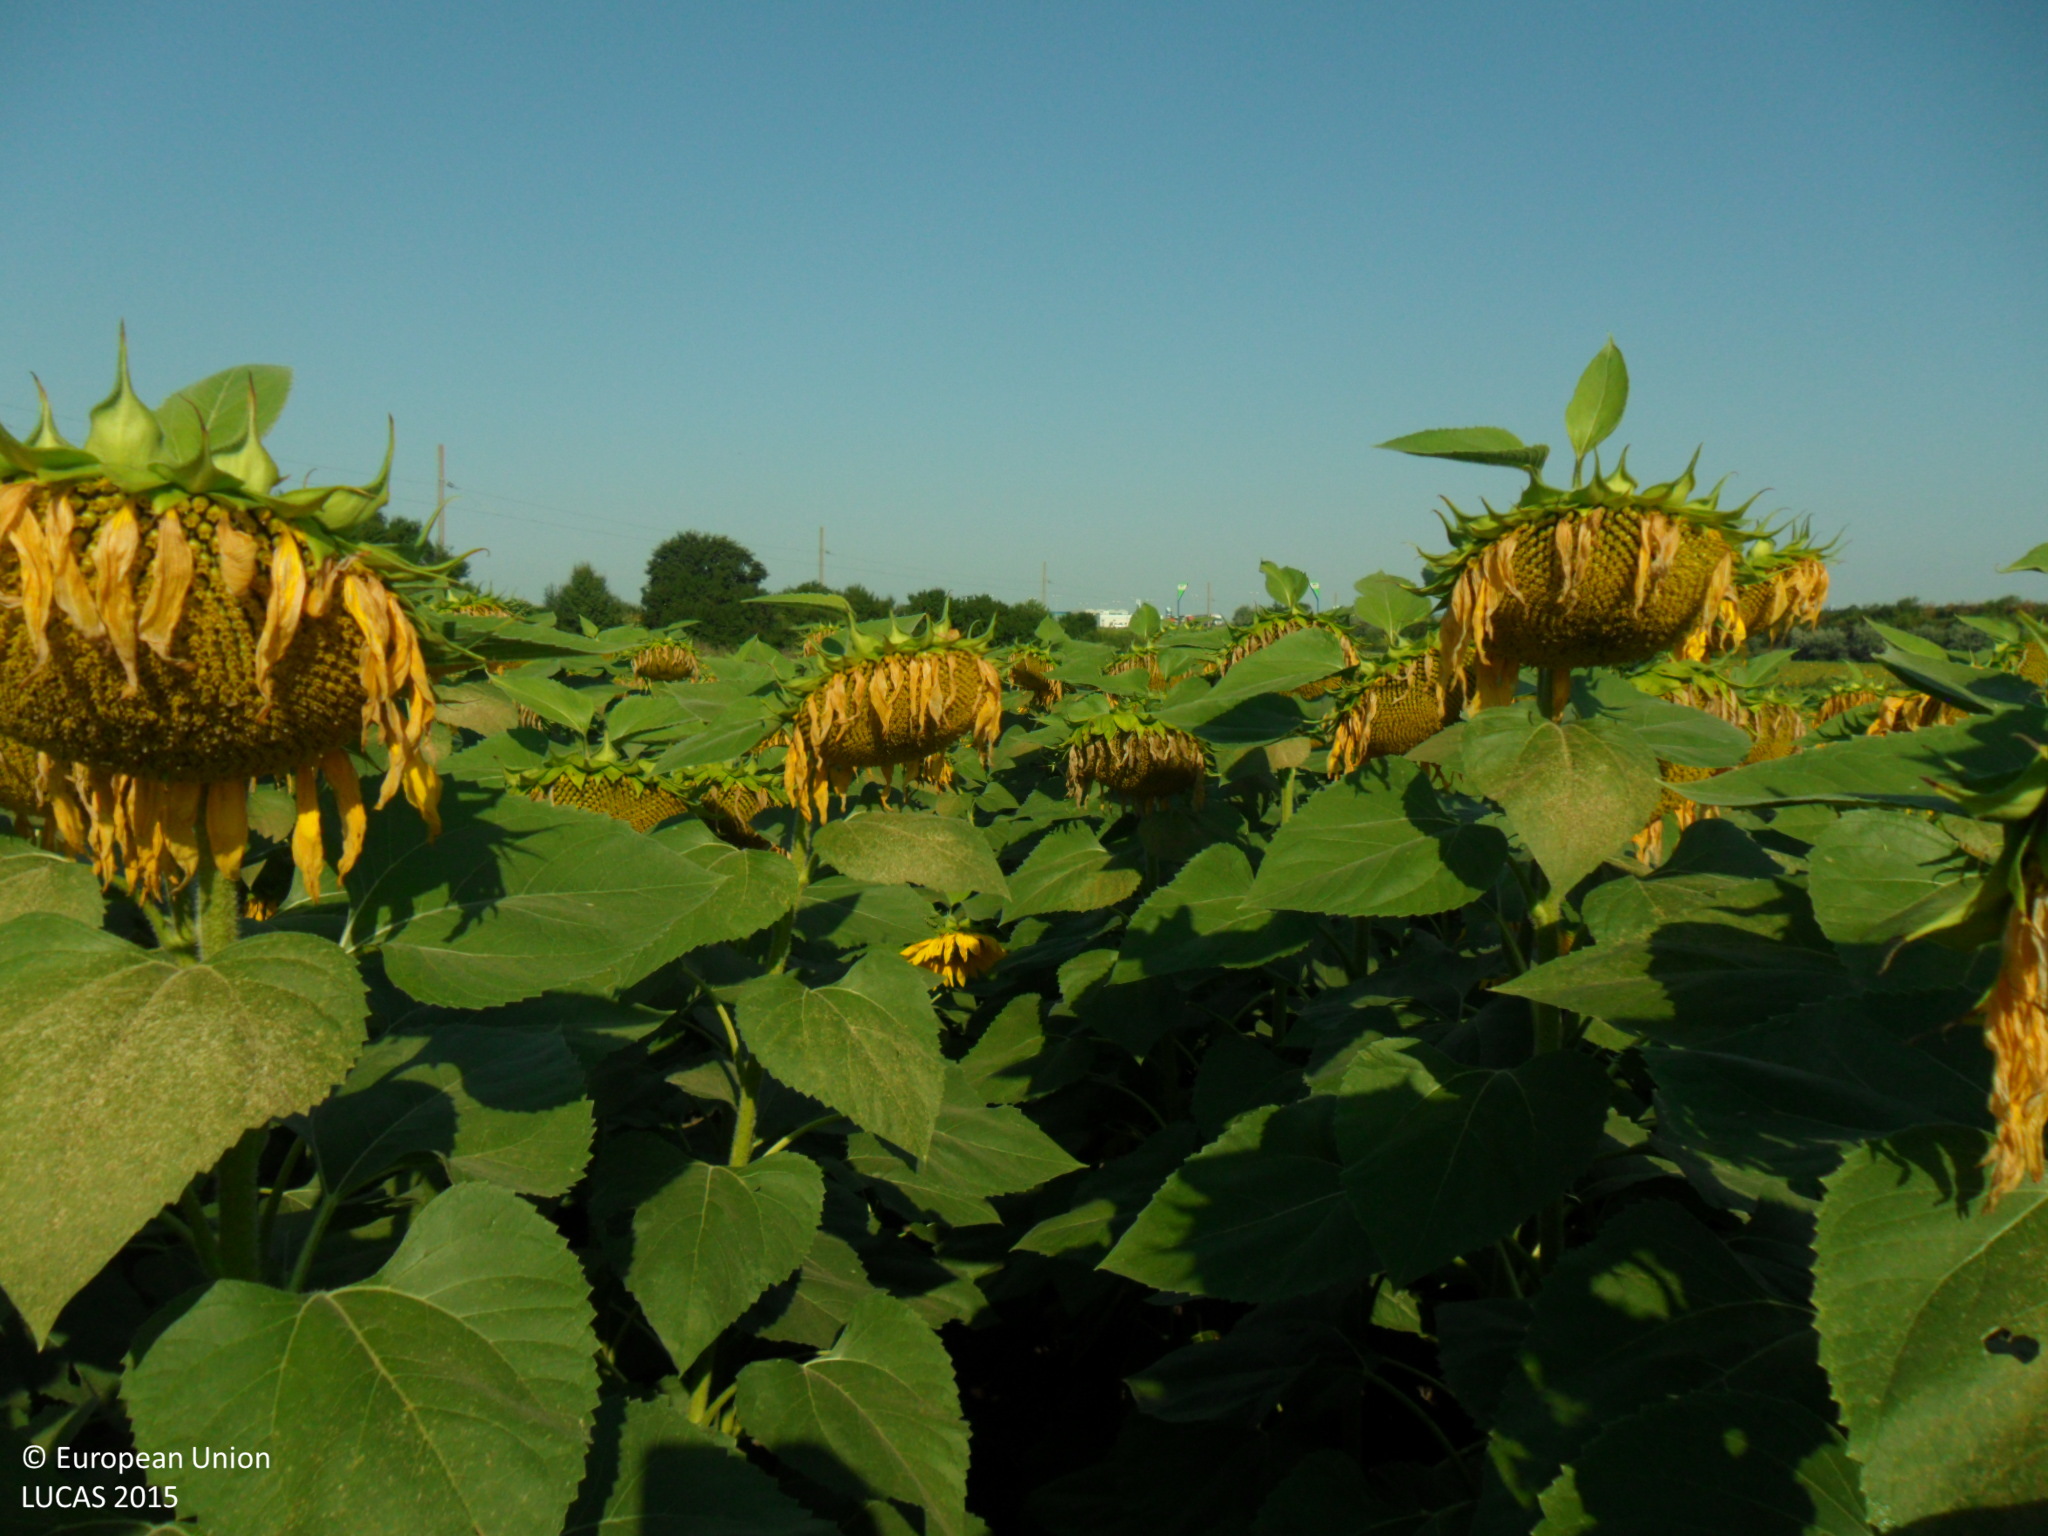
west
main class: Cropland
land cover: Sunflower
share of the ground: > 75 %
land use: Agriculture (excluding fallow land and kitchen gardens)
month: July
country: BG
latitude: 43.3194
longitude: 27.1226
